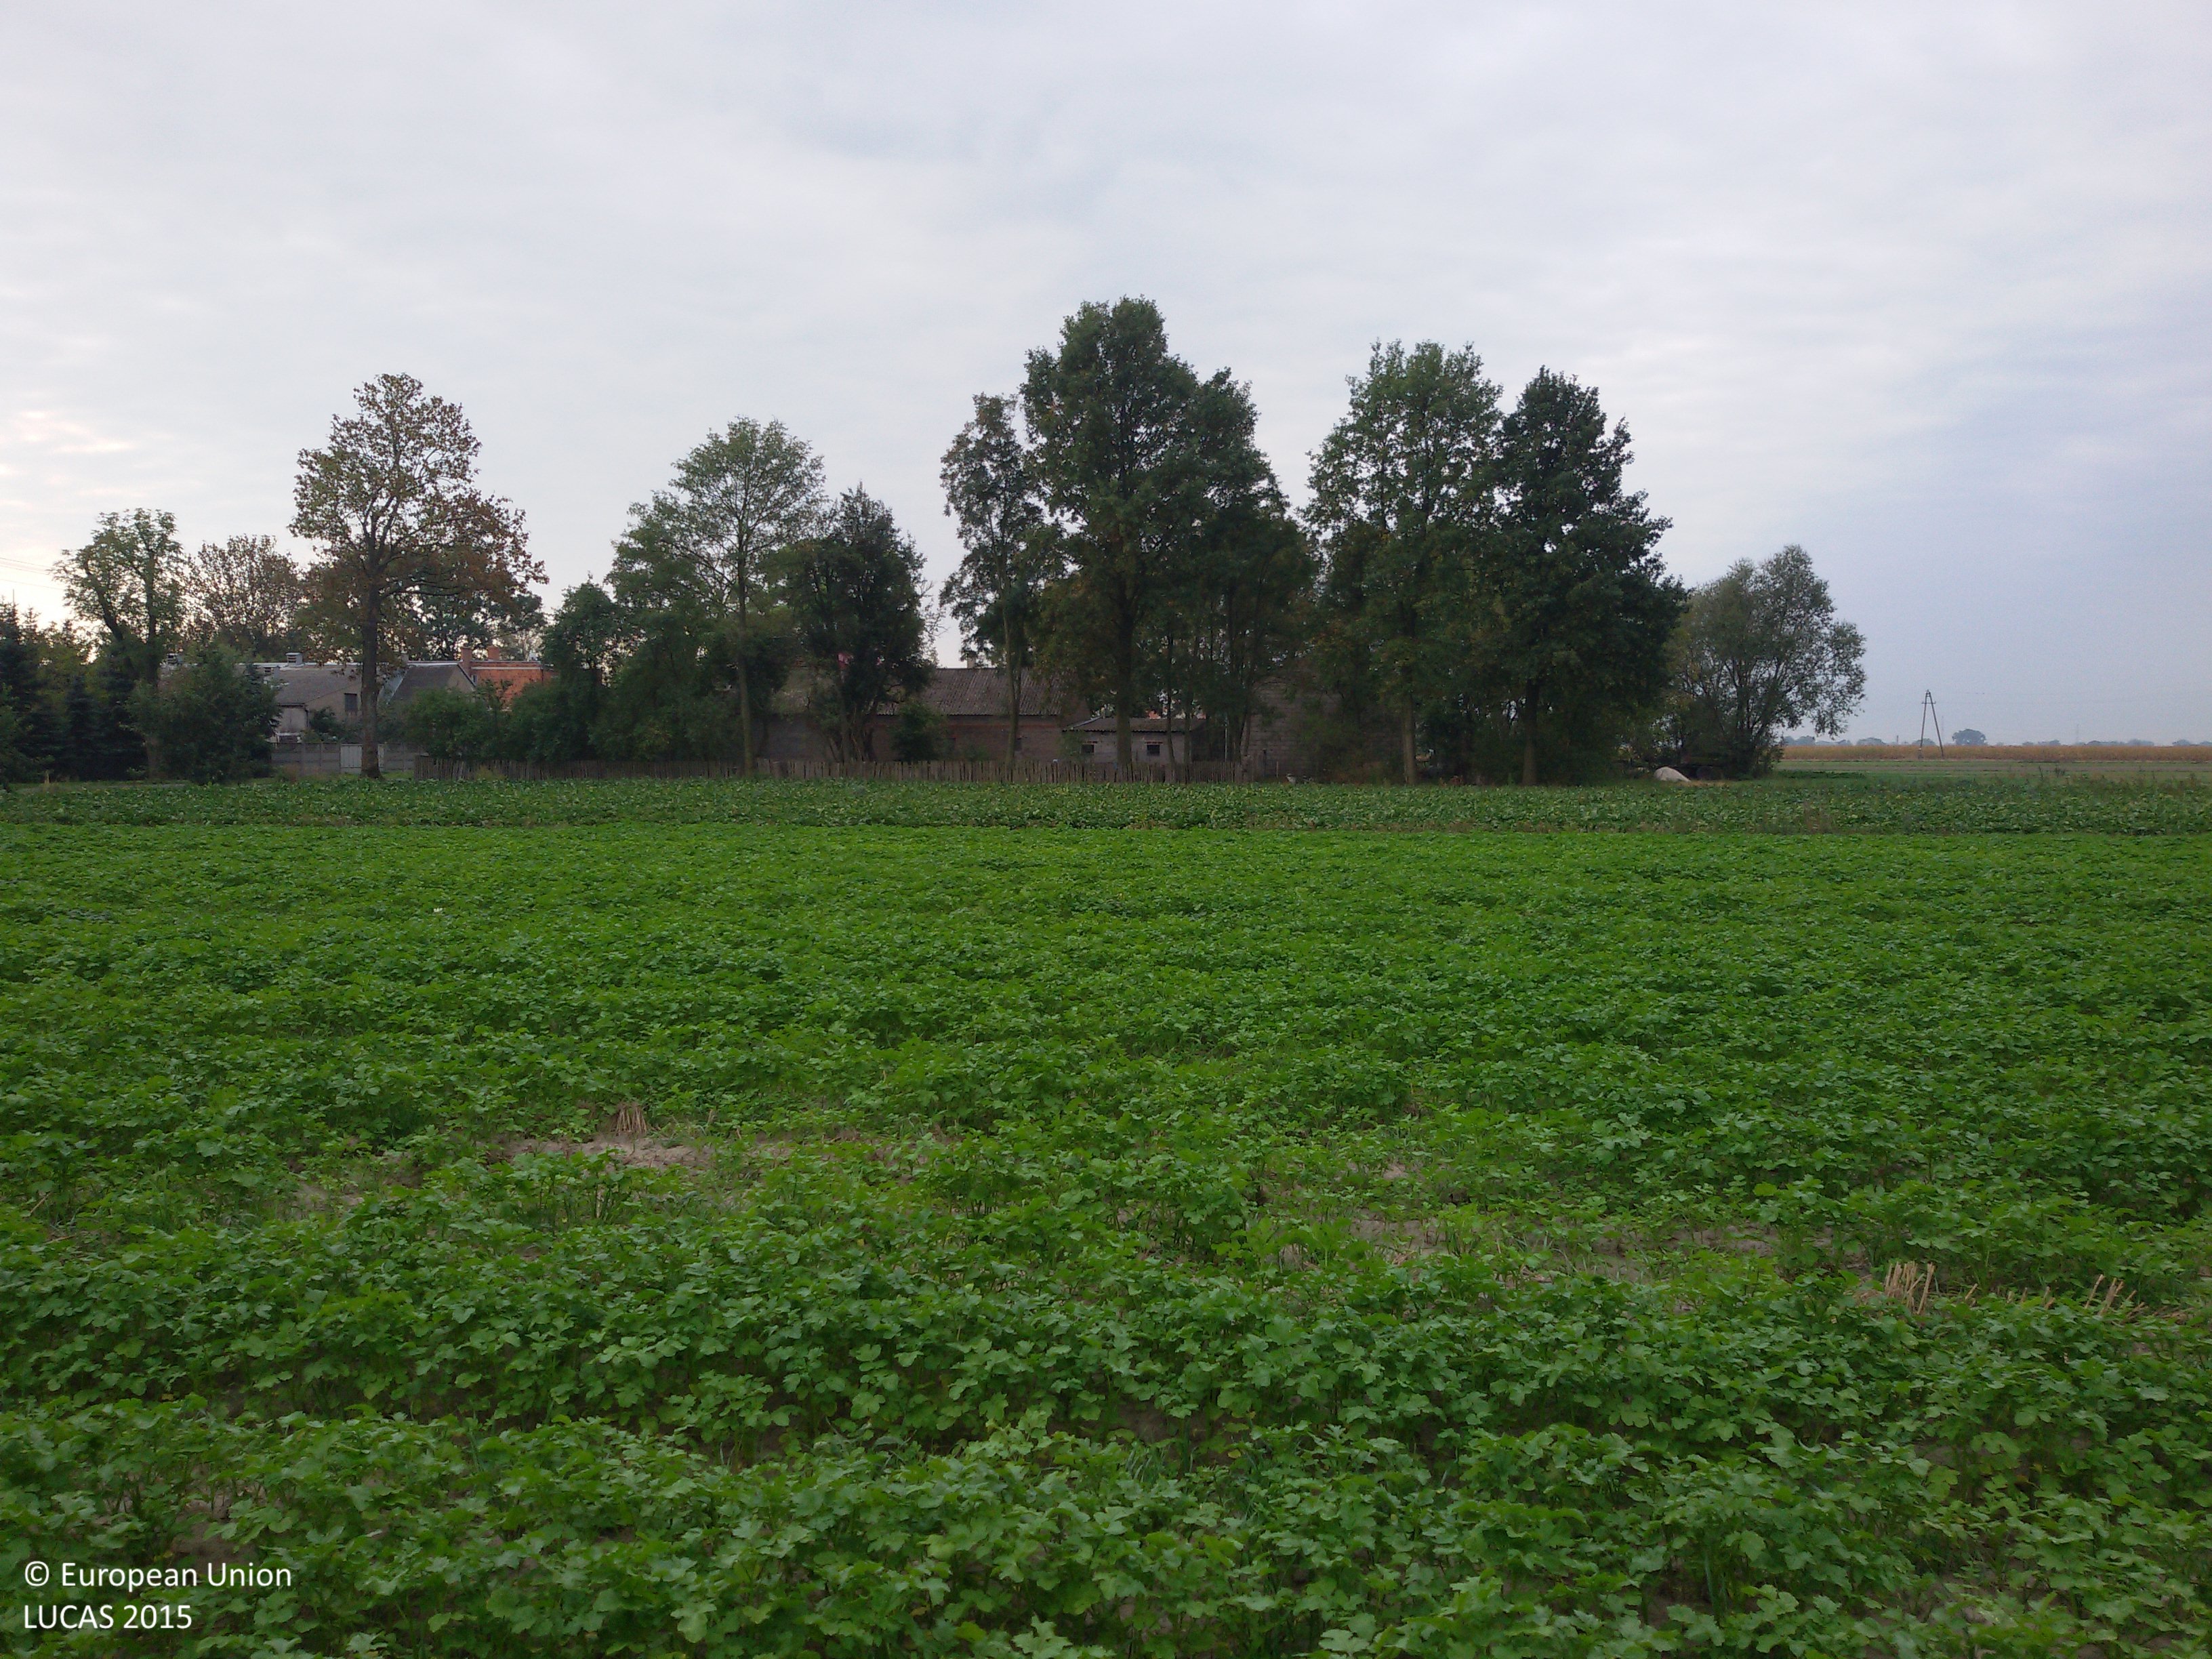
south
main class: Cropland
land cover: Rape and turnip rape
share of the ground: > 75 %
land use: Agriculture (excluding fallow land and kitchen gardens)
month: September
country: PL
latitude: 52.2895
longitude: 17.9763
